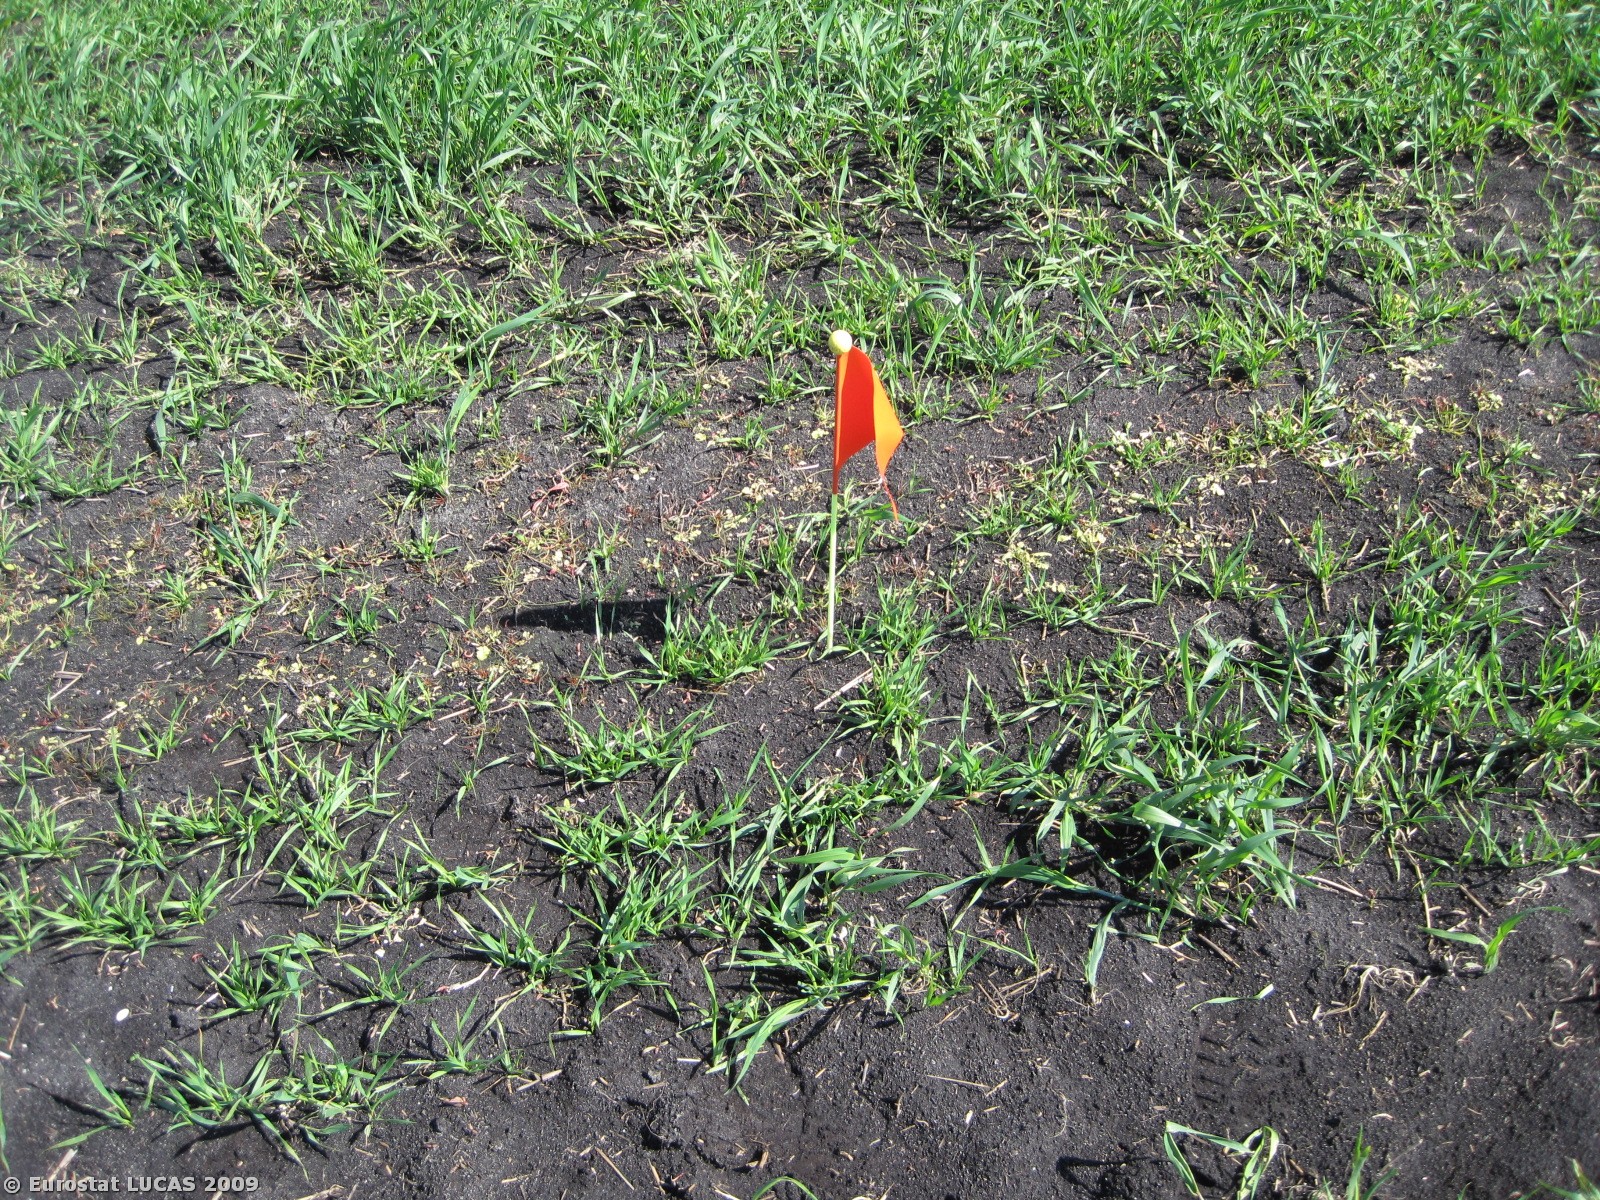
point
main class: Cropland
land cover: Barley
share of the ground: 50 - 75 %
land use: Agriculture (excluding fallow land and kitchen gardens)
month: May
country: DK
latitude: 56.9068
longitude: 10.0820
